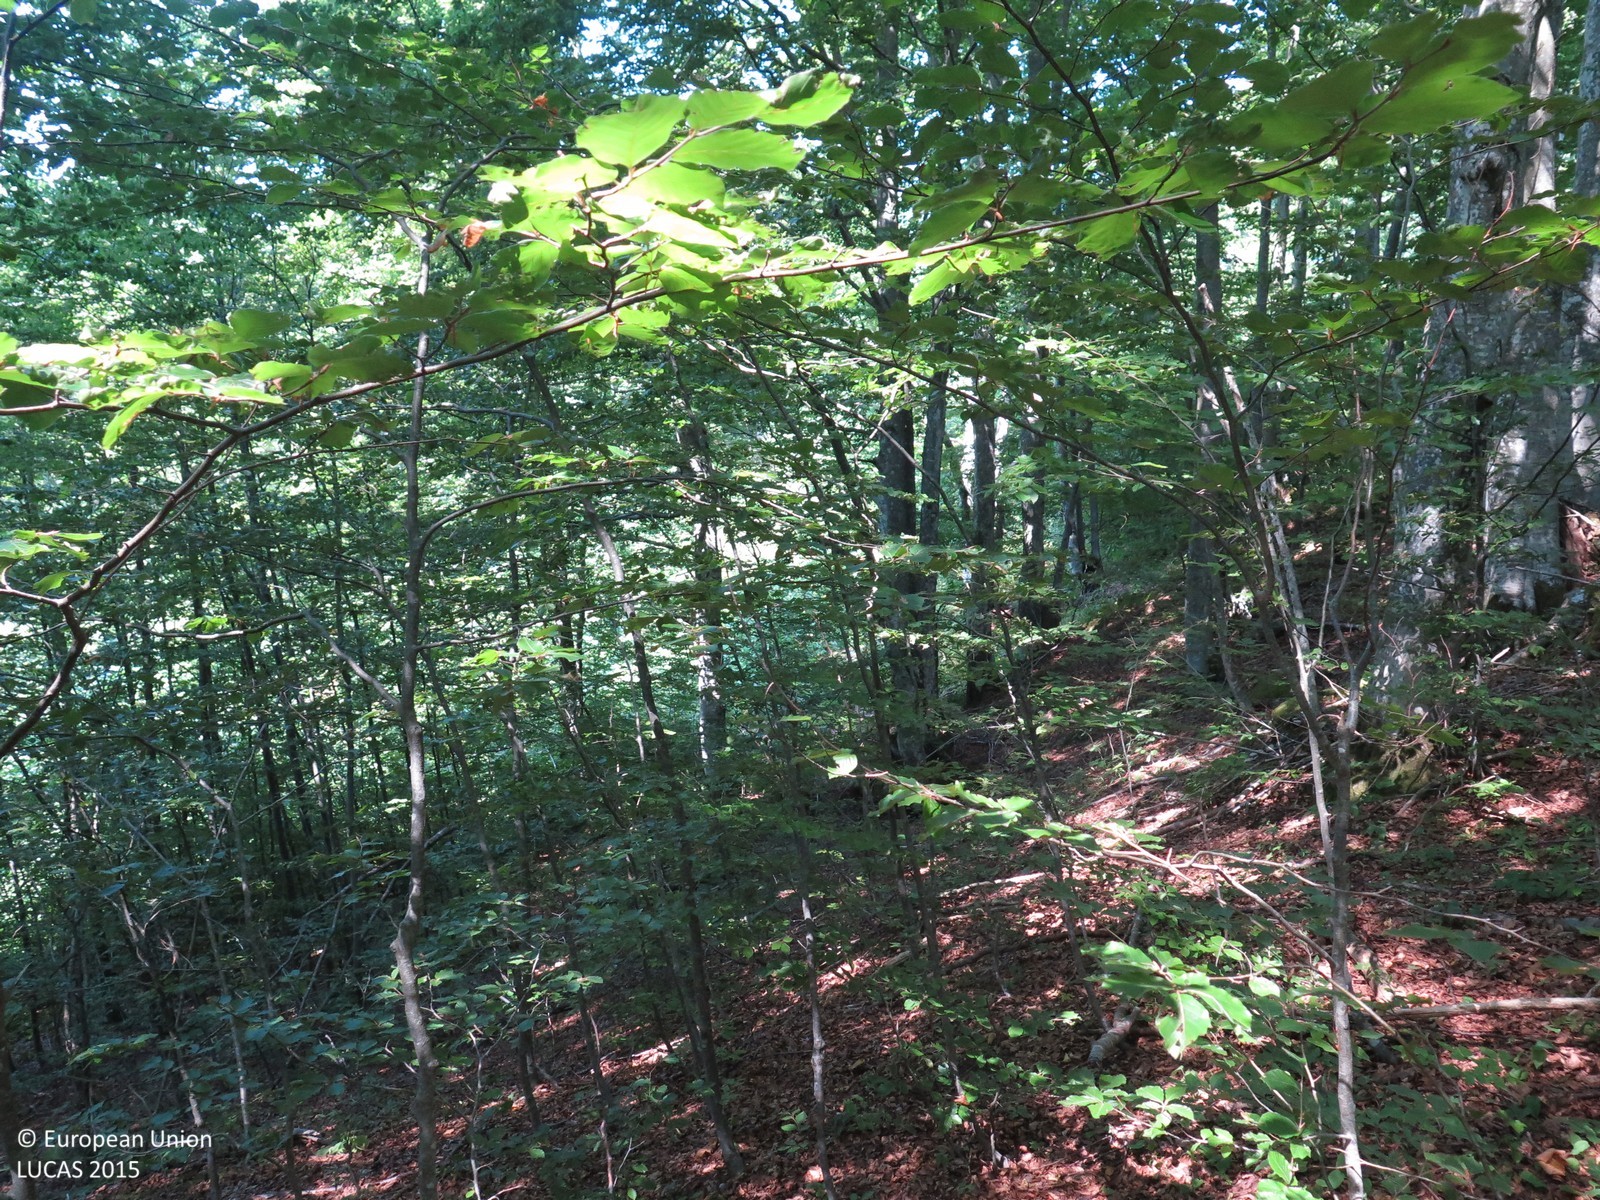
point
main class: Woodland
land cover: Broadleaved woodland
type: beech forest
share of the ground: > 75 %
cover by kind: broadleaved forest trees 95 %, unconsolidated bare surface 5 %
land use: Forestry
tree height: > 5 m
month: August
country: HR
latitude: 45.3745
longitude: 14.8604
